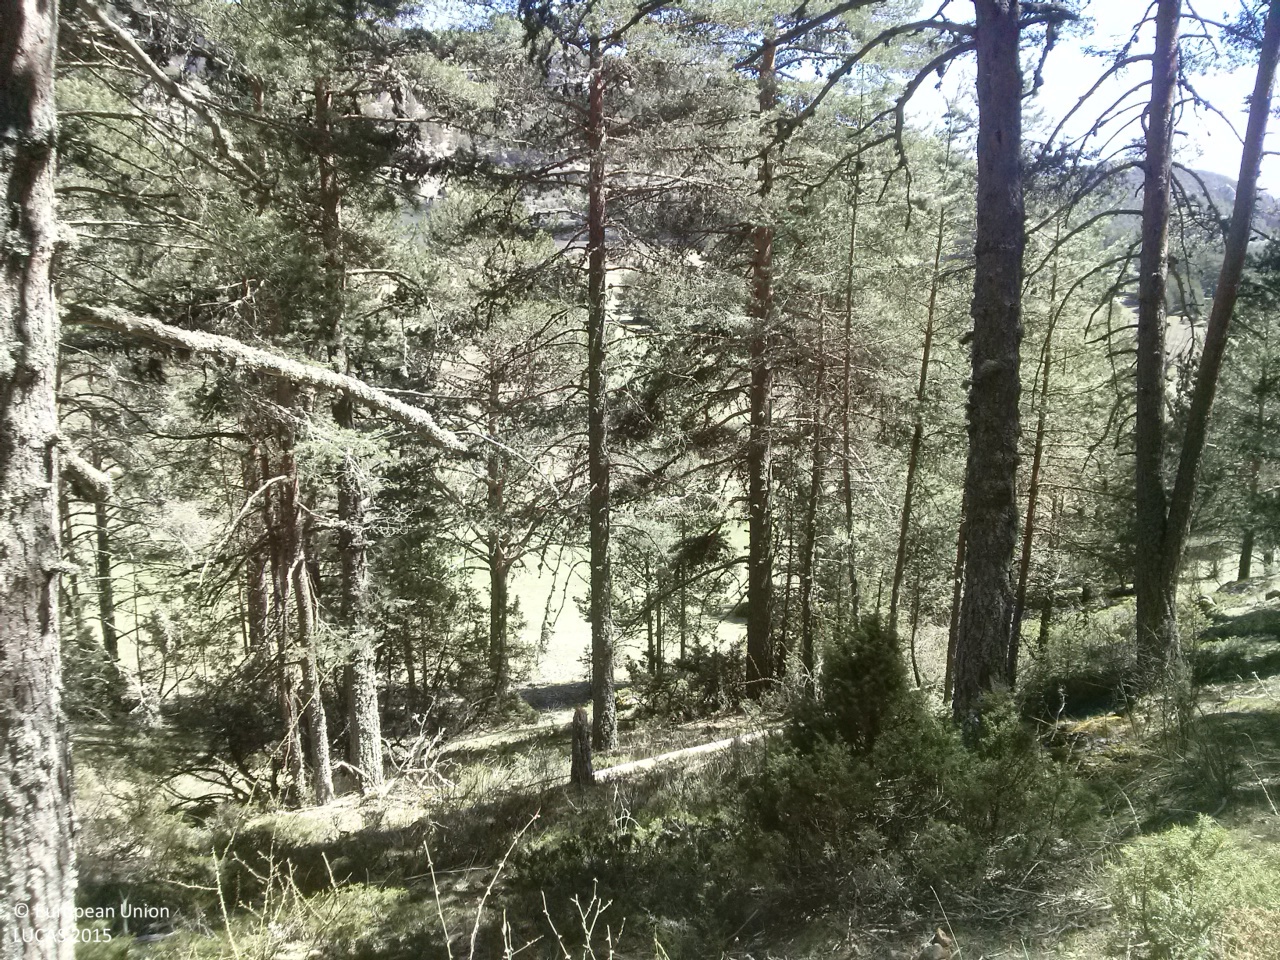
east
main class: Woodland
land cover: Pine dominated coniferous woodland
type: coniferous forest of the mediterranean region
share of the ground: > 75 %
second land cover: Grassland without tree/shrub cover
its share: > 75 %
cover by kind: coniferous forest trees 80 %, herbaceous plants 20 %
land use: Forestry
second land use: Agriculture (excluding fallow land and kitchen gardens)
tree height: > 5 m
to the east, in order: Pine dominated coniferous woodland; Grassland without tree/shrub cover; Pine dominated coniferous woodland; Grassland without tree/shrub cover; Single bushes/trees; Grassland without tree/shrub cover; Ponds and wetlands; Grassland without tree/shrub cover
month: April
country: ES
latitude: 40.4329
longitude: -1.7694
